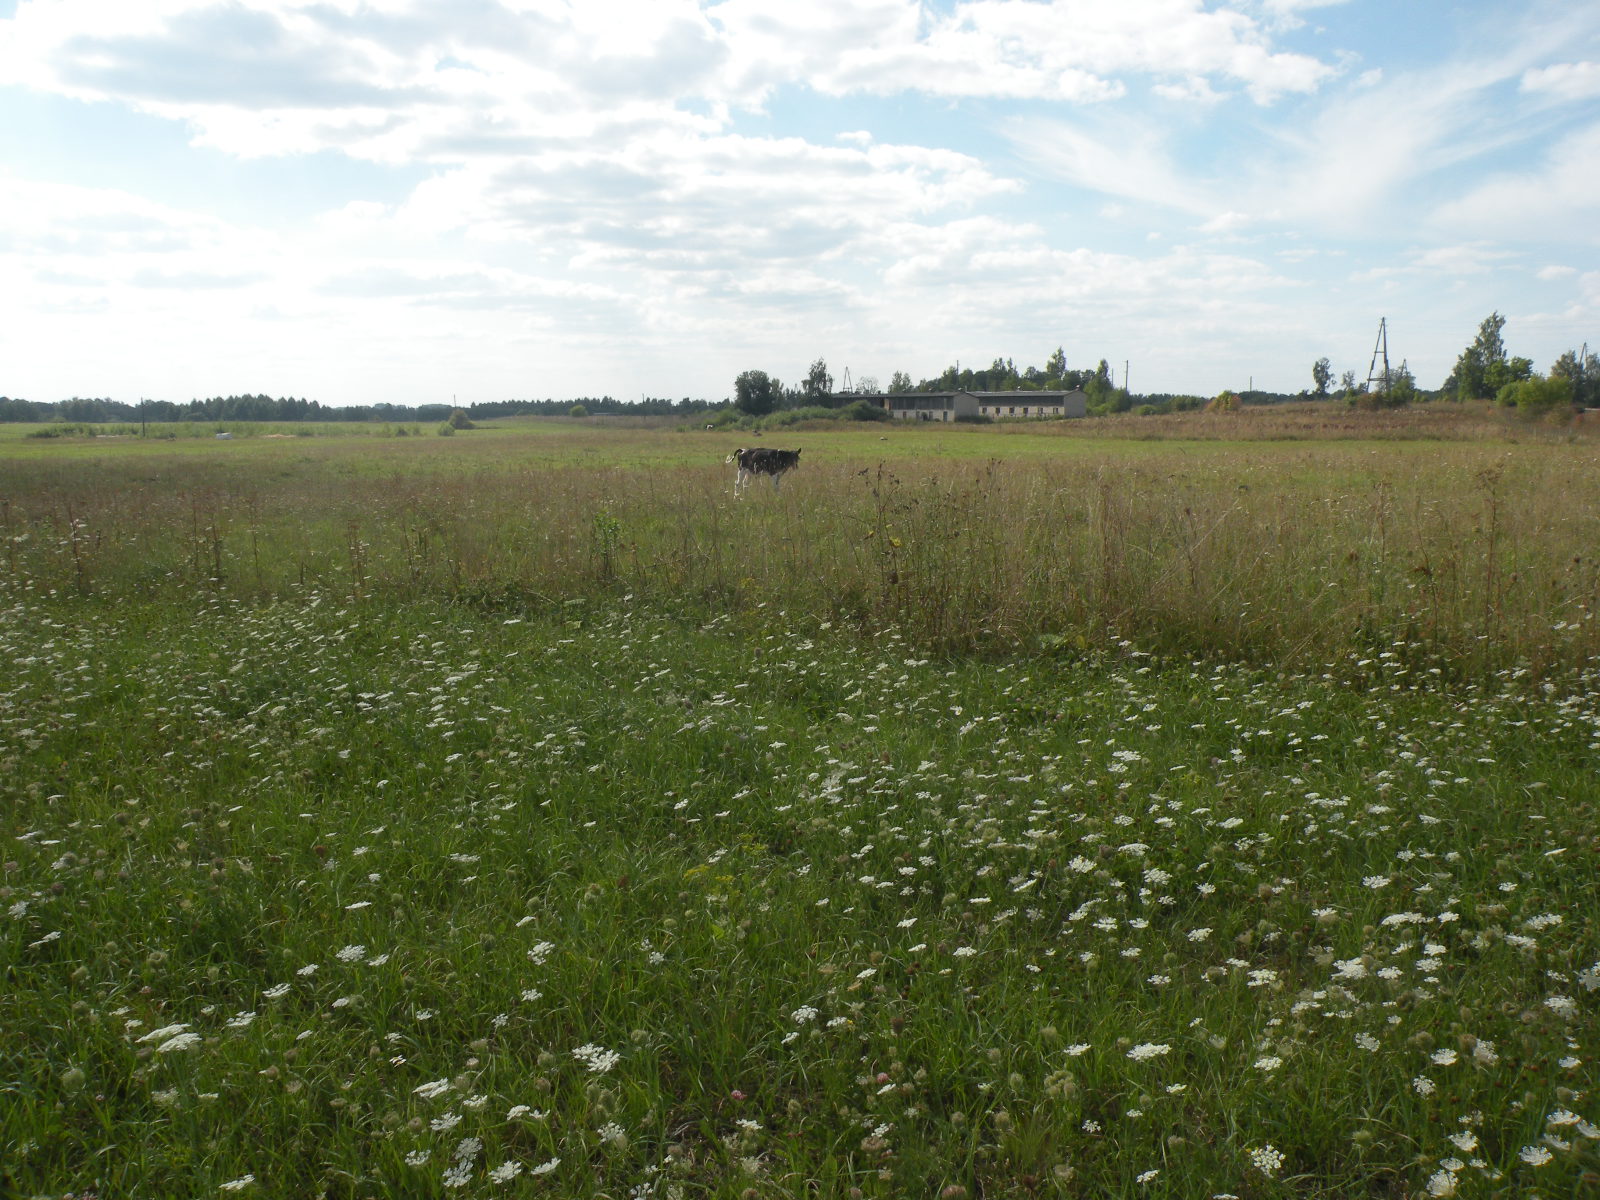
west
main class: Grassland
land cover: Grassland without tree/shrub cover
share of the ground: > 75 %
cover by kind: herbaceous plants 95 %, unconsolidated bare surface 5 %
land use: Agriculture (excluding fallow land and kitchen gardens)
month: August
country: LV
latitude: 55.7290
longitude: 26.5375
